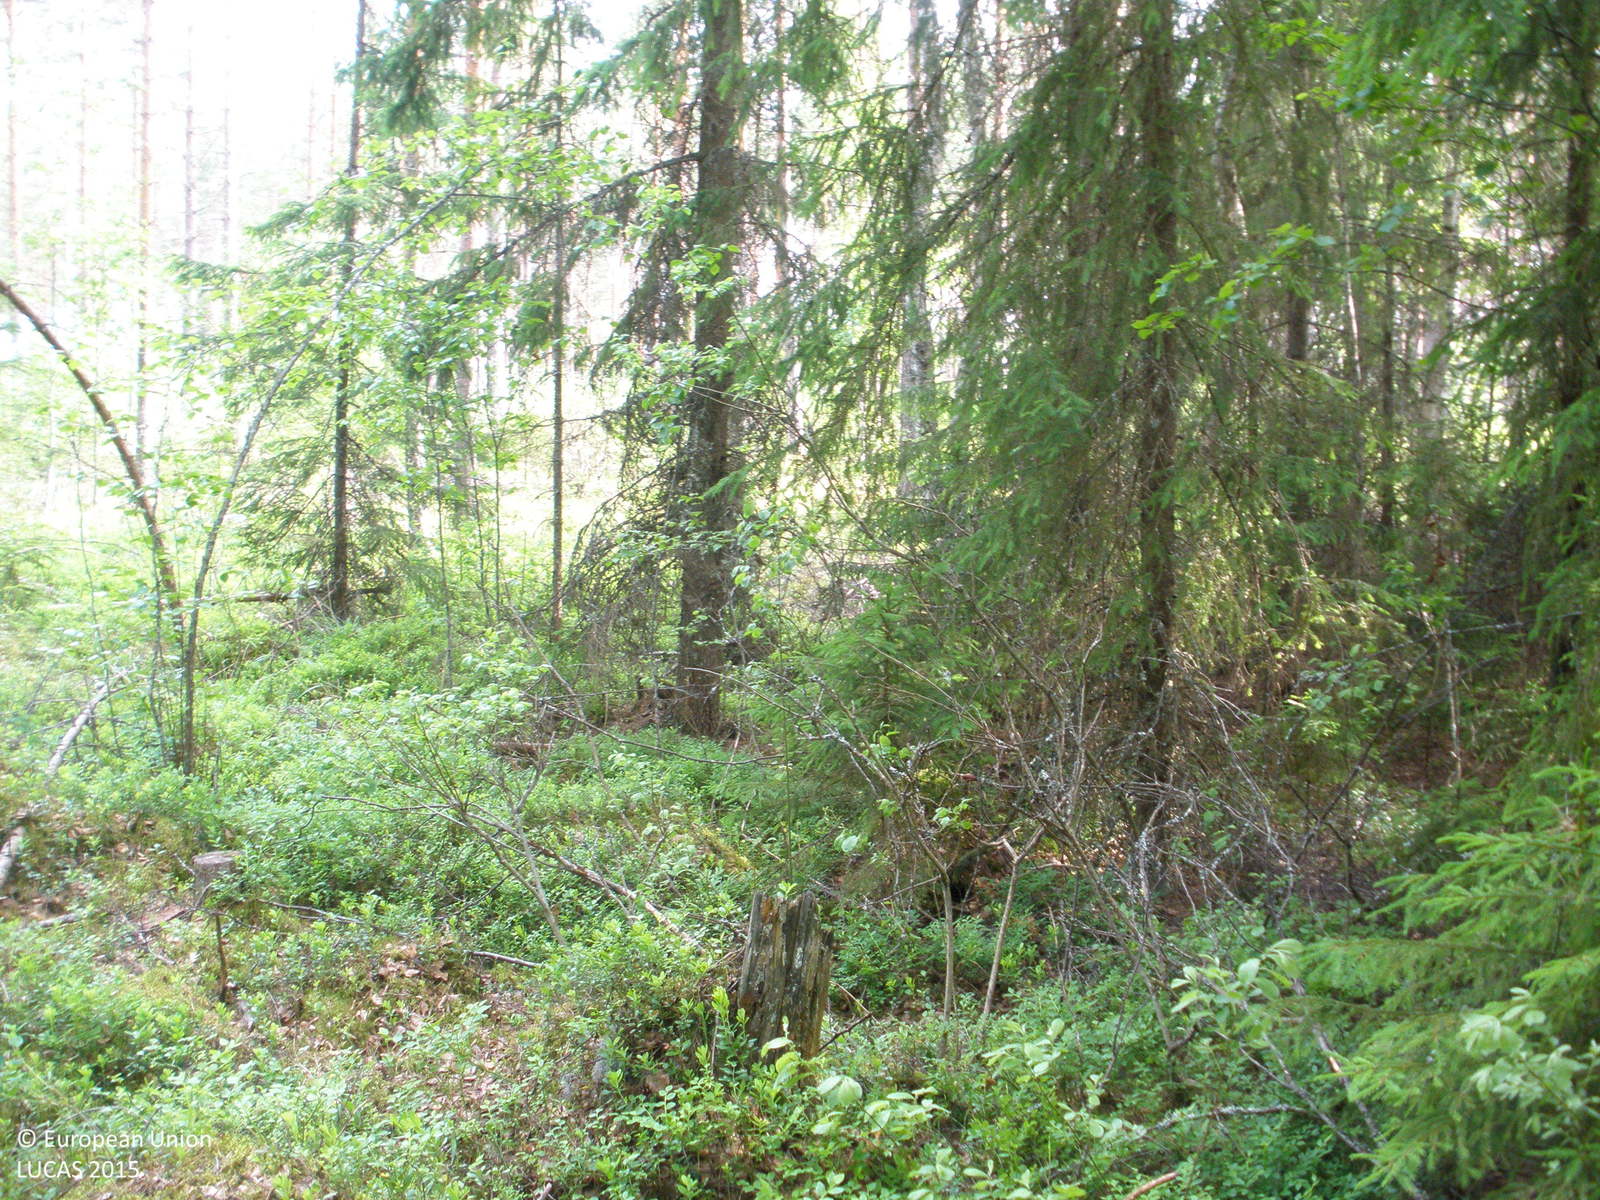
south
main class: Woodland
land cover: Spruce dominated mixed woodland
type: boreal forest
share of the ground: > 75 %
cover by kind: coniferous forest trees 55 %, broadleaved forest trees 25 %, herbaceous plants 10 %, lichens and mosses 10 %
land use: Forestry
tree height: > 5 m
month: June
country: FI
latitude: 61.1080
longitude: 24.7460
